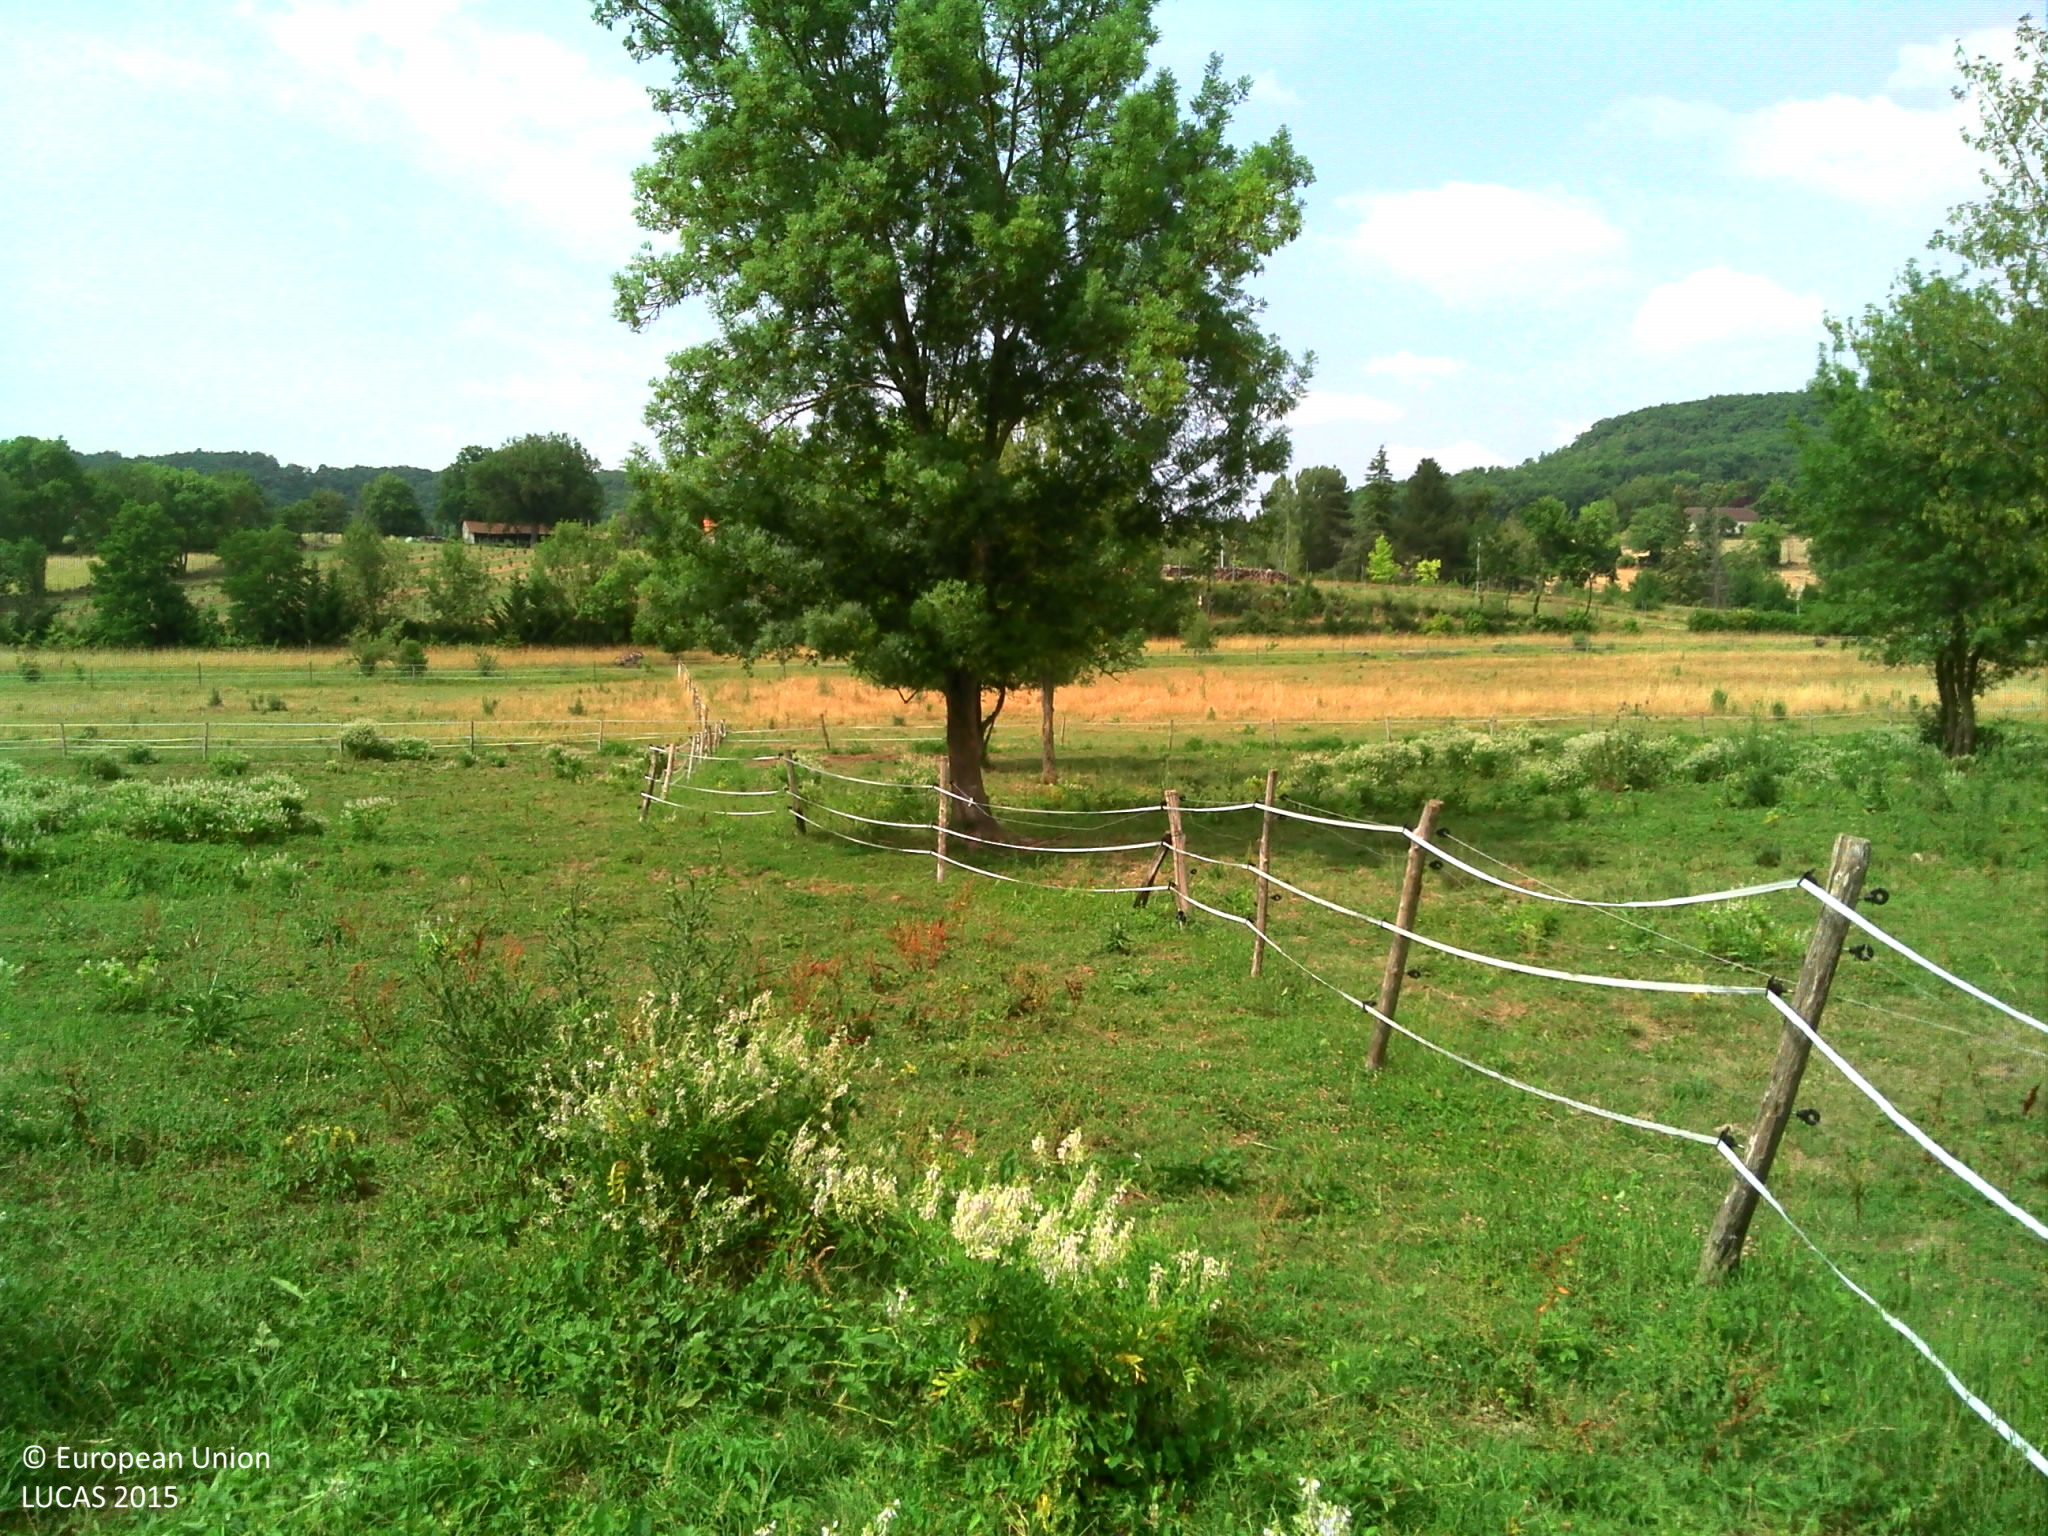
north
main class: Grassland
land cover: Grassland with sparse tree/shrub cover
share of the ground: > 75 %
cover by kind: herbaceous plants 95 %, broadleaved forest trees 5 %
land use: Agriculture (excluding fallow land and kitchen gardens)
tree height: > 5 m
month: July
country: FR
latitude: 44.3805
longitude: 0.8452
